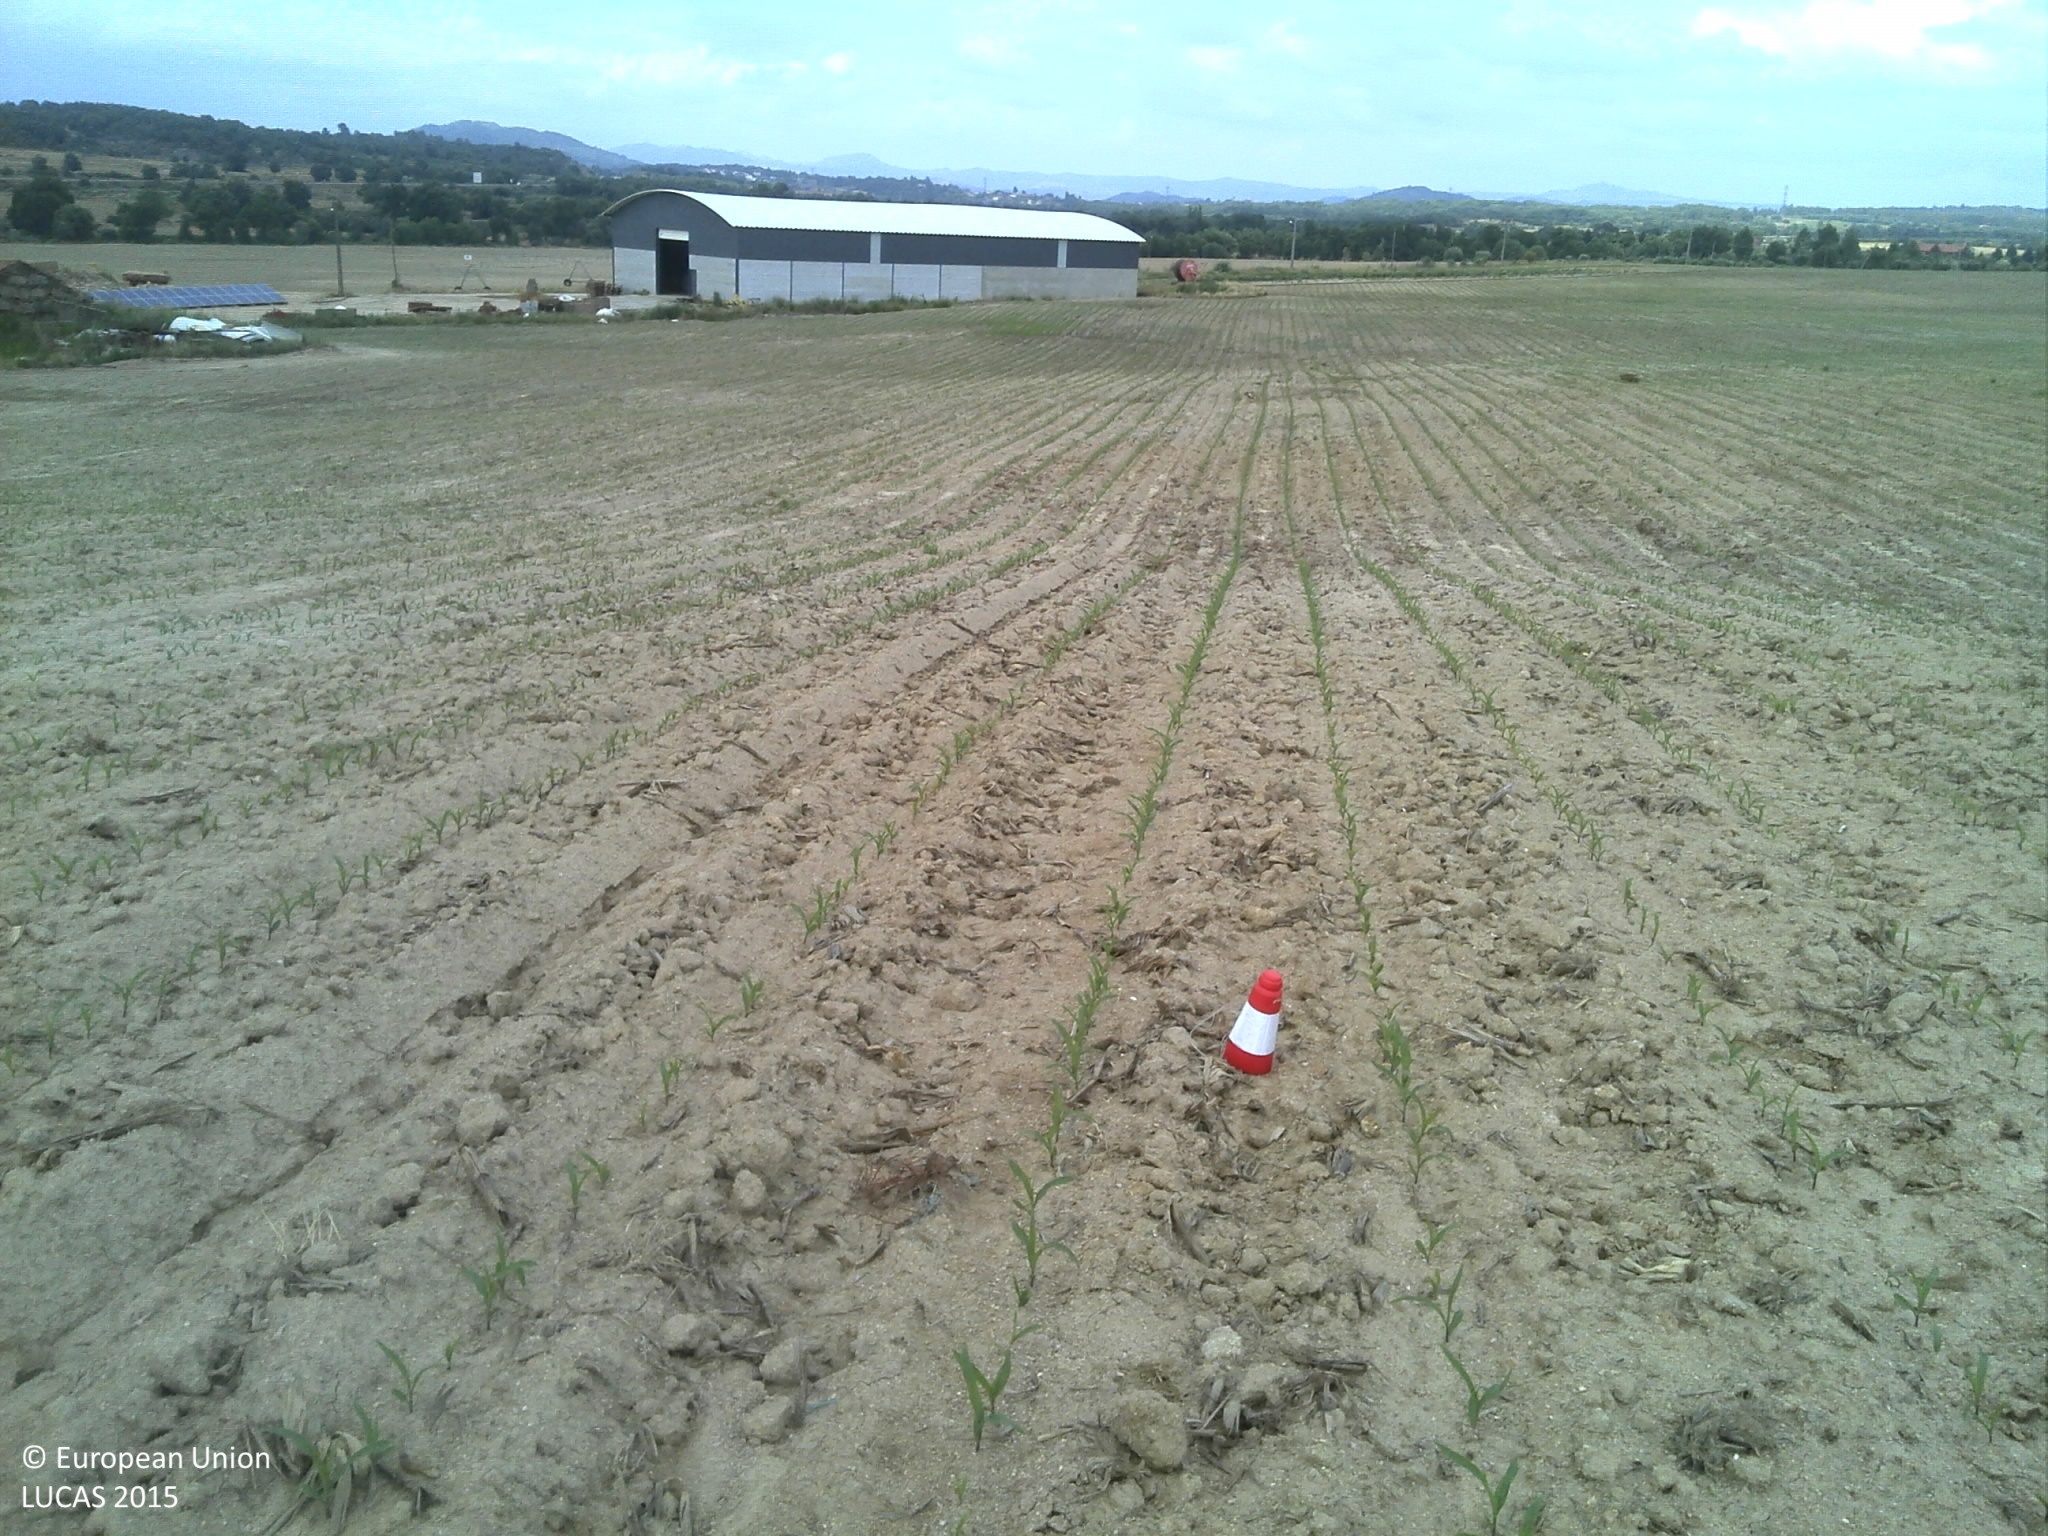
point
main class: Cropland
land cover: Maize
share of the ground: < 10 %
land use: Agriculture (excluding fallow land and kitchen gardens)
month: June
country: PT
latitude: 40.2630
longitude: -7.4253
